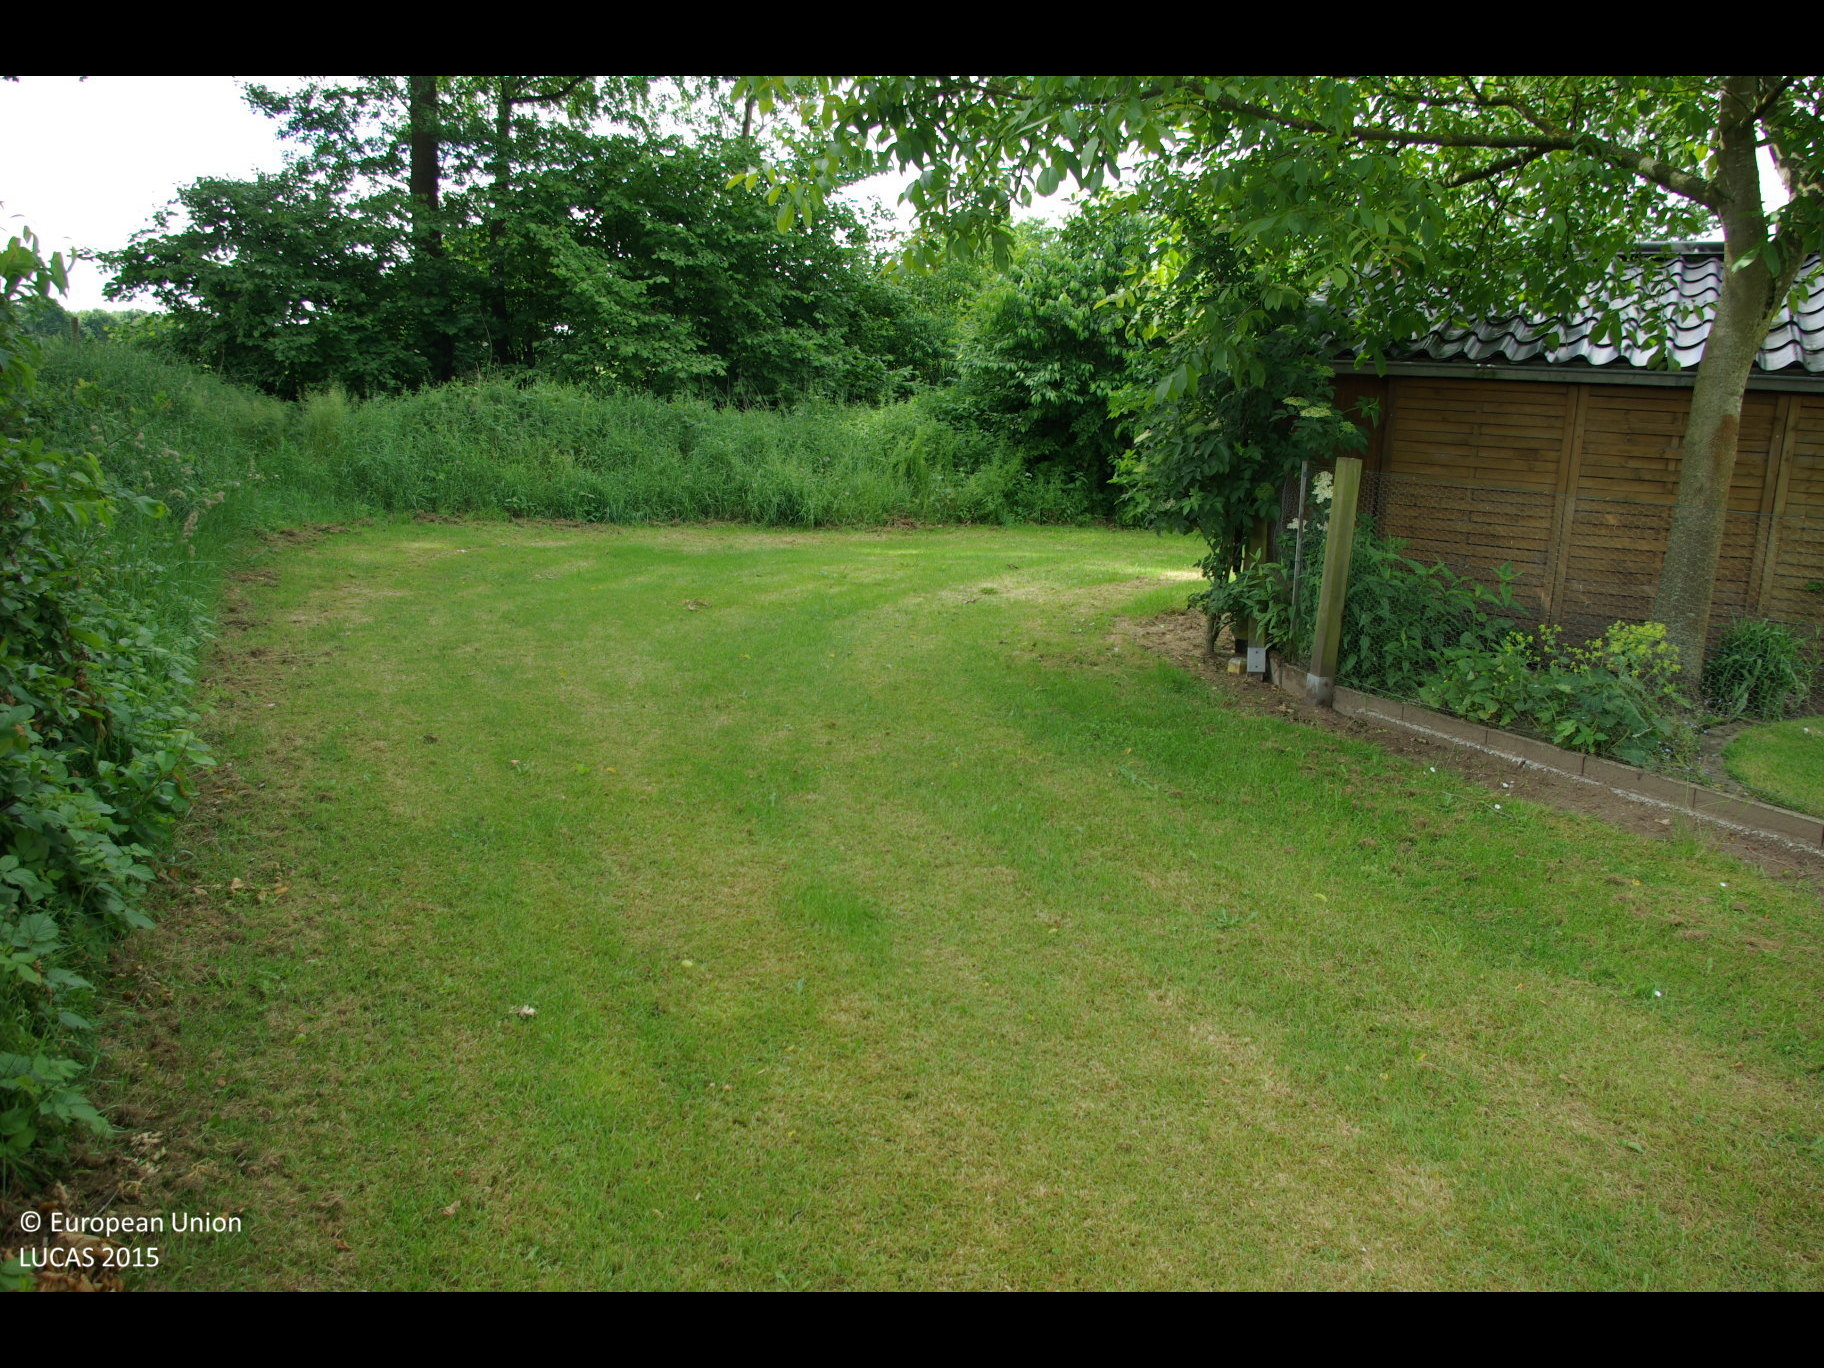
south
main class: Grassland
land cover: Grassland without tree/shrub cover
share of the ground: > 75 %
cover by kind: herbaceous plants 100 %
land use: Residential
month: June
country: DE
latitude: 54.0489
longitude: 9.9542
